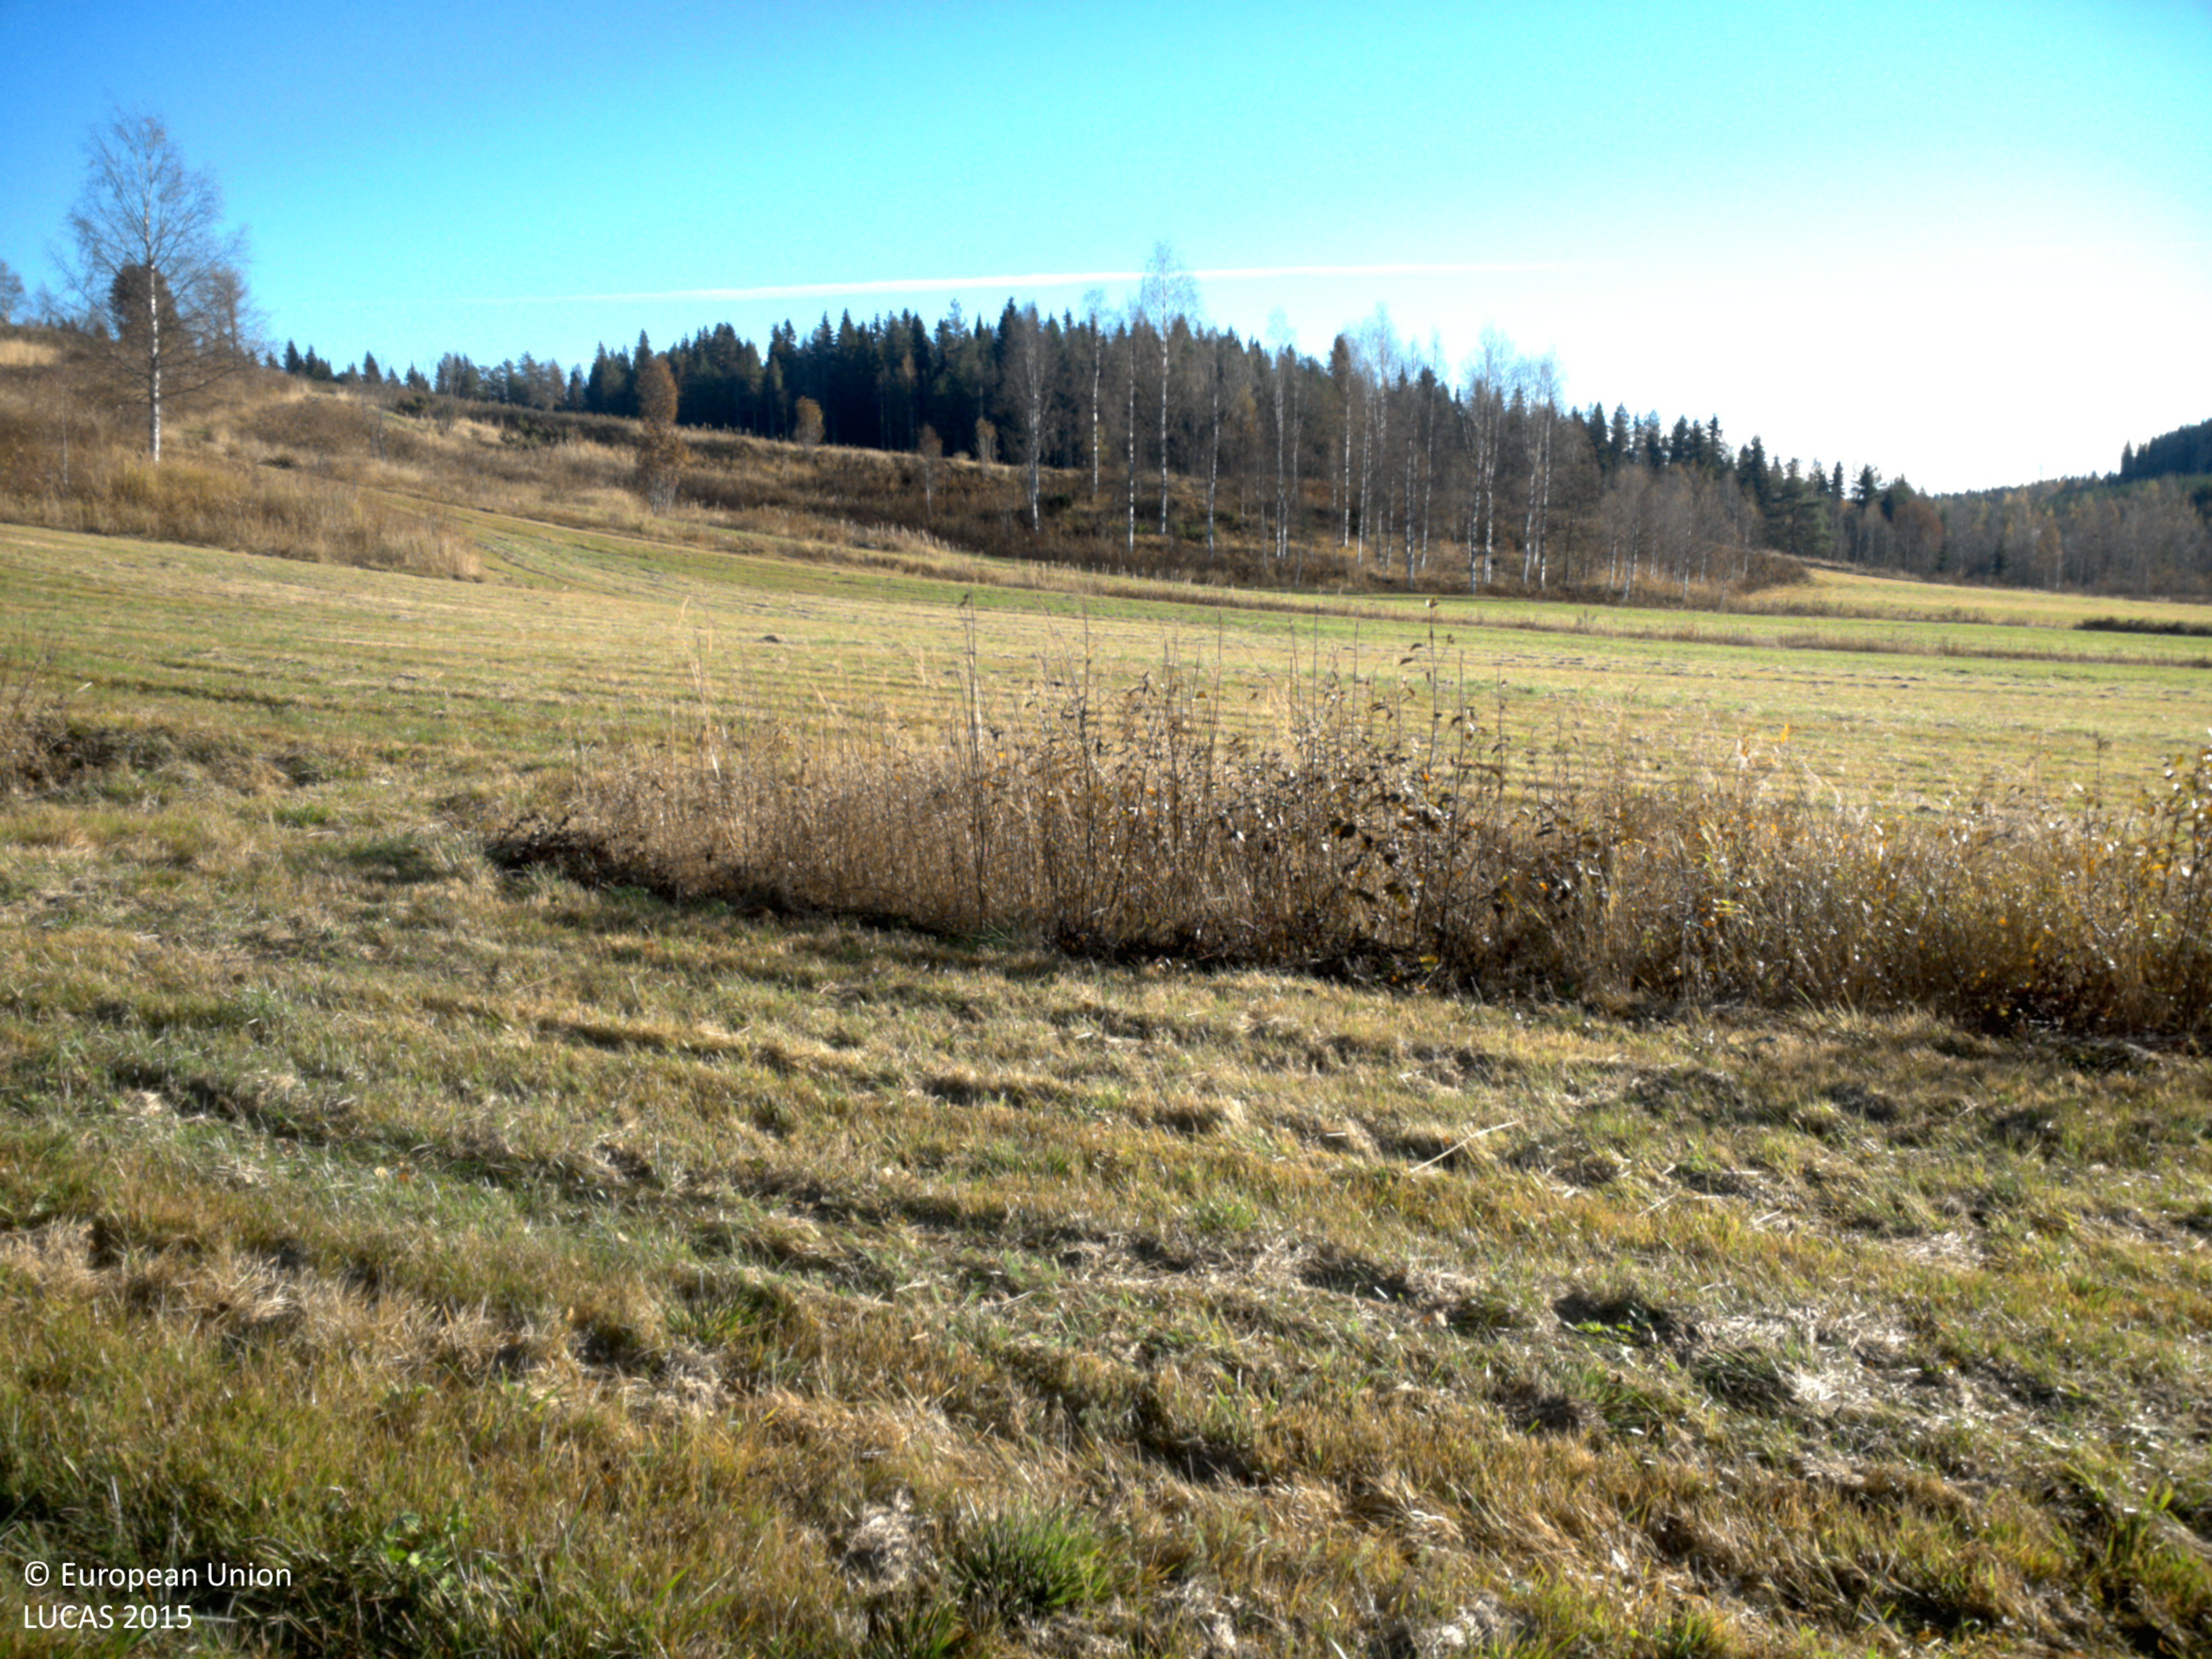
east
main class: Grassland
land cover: Grassland without tree/shrub cover
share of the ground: > 75 %
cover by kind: herbaceous plants 95 %, lichens and mosses 5 %
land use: Agriculture (excluding fallow land and kitchen gardens)
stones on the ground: < 10 %
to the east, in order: Grassland without tree/shrub cover; Ditches and canals; Grassland without tree/shrub cover; Ditches and canals; Grassland without tree/shrub cover; Ditches and canals; Broadleaved woodland; Grassland without tree/shrub cover; Ditches and canals; Grassland without tree/shrub cover
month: October
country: SE
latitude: 64.0408
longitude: 19.7849
